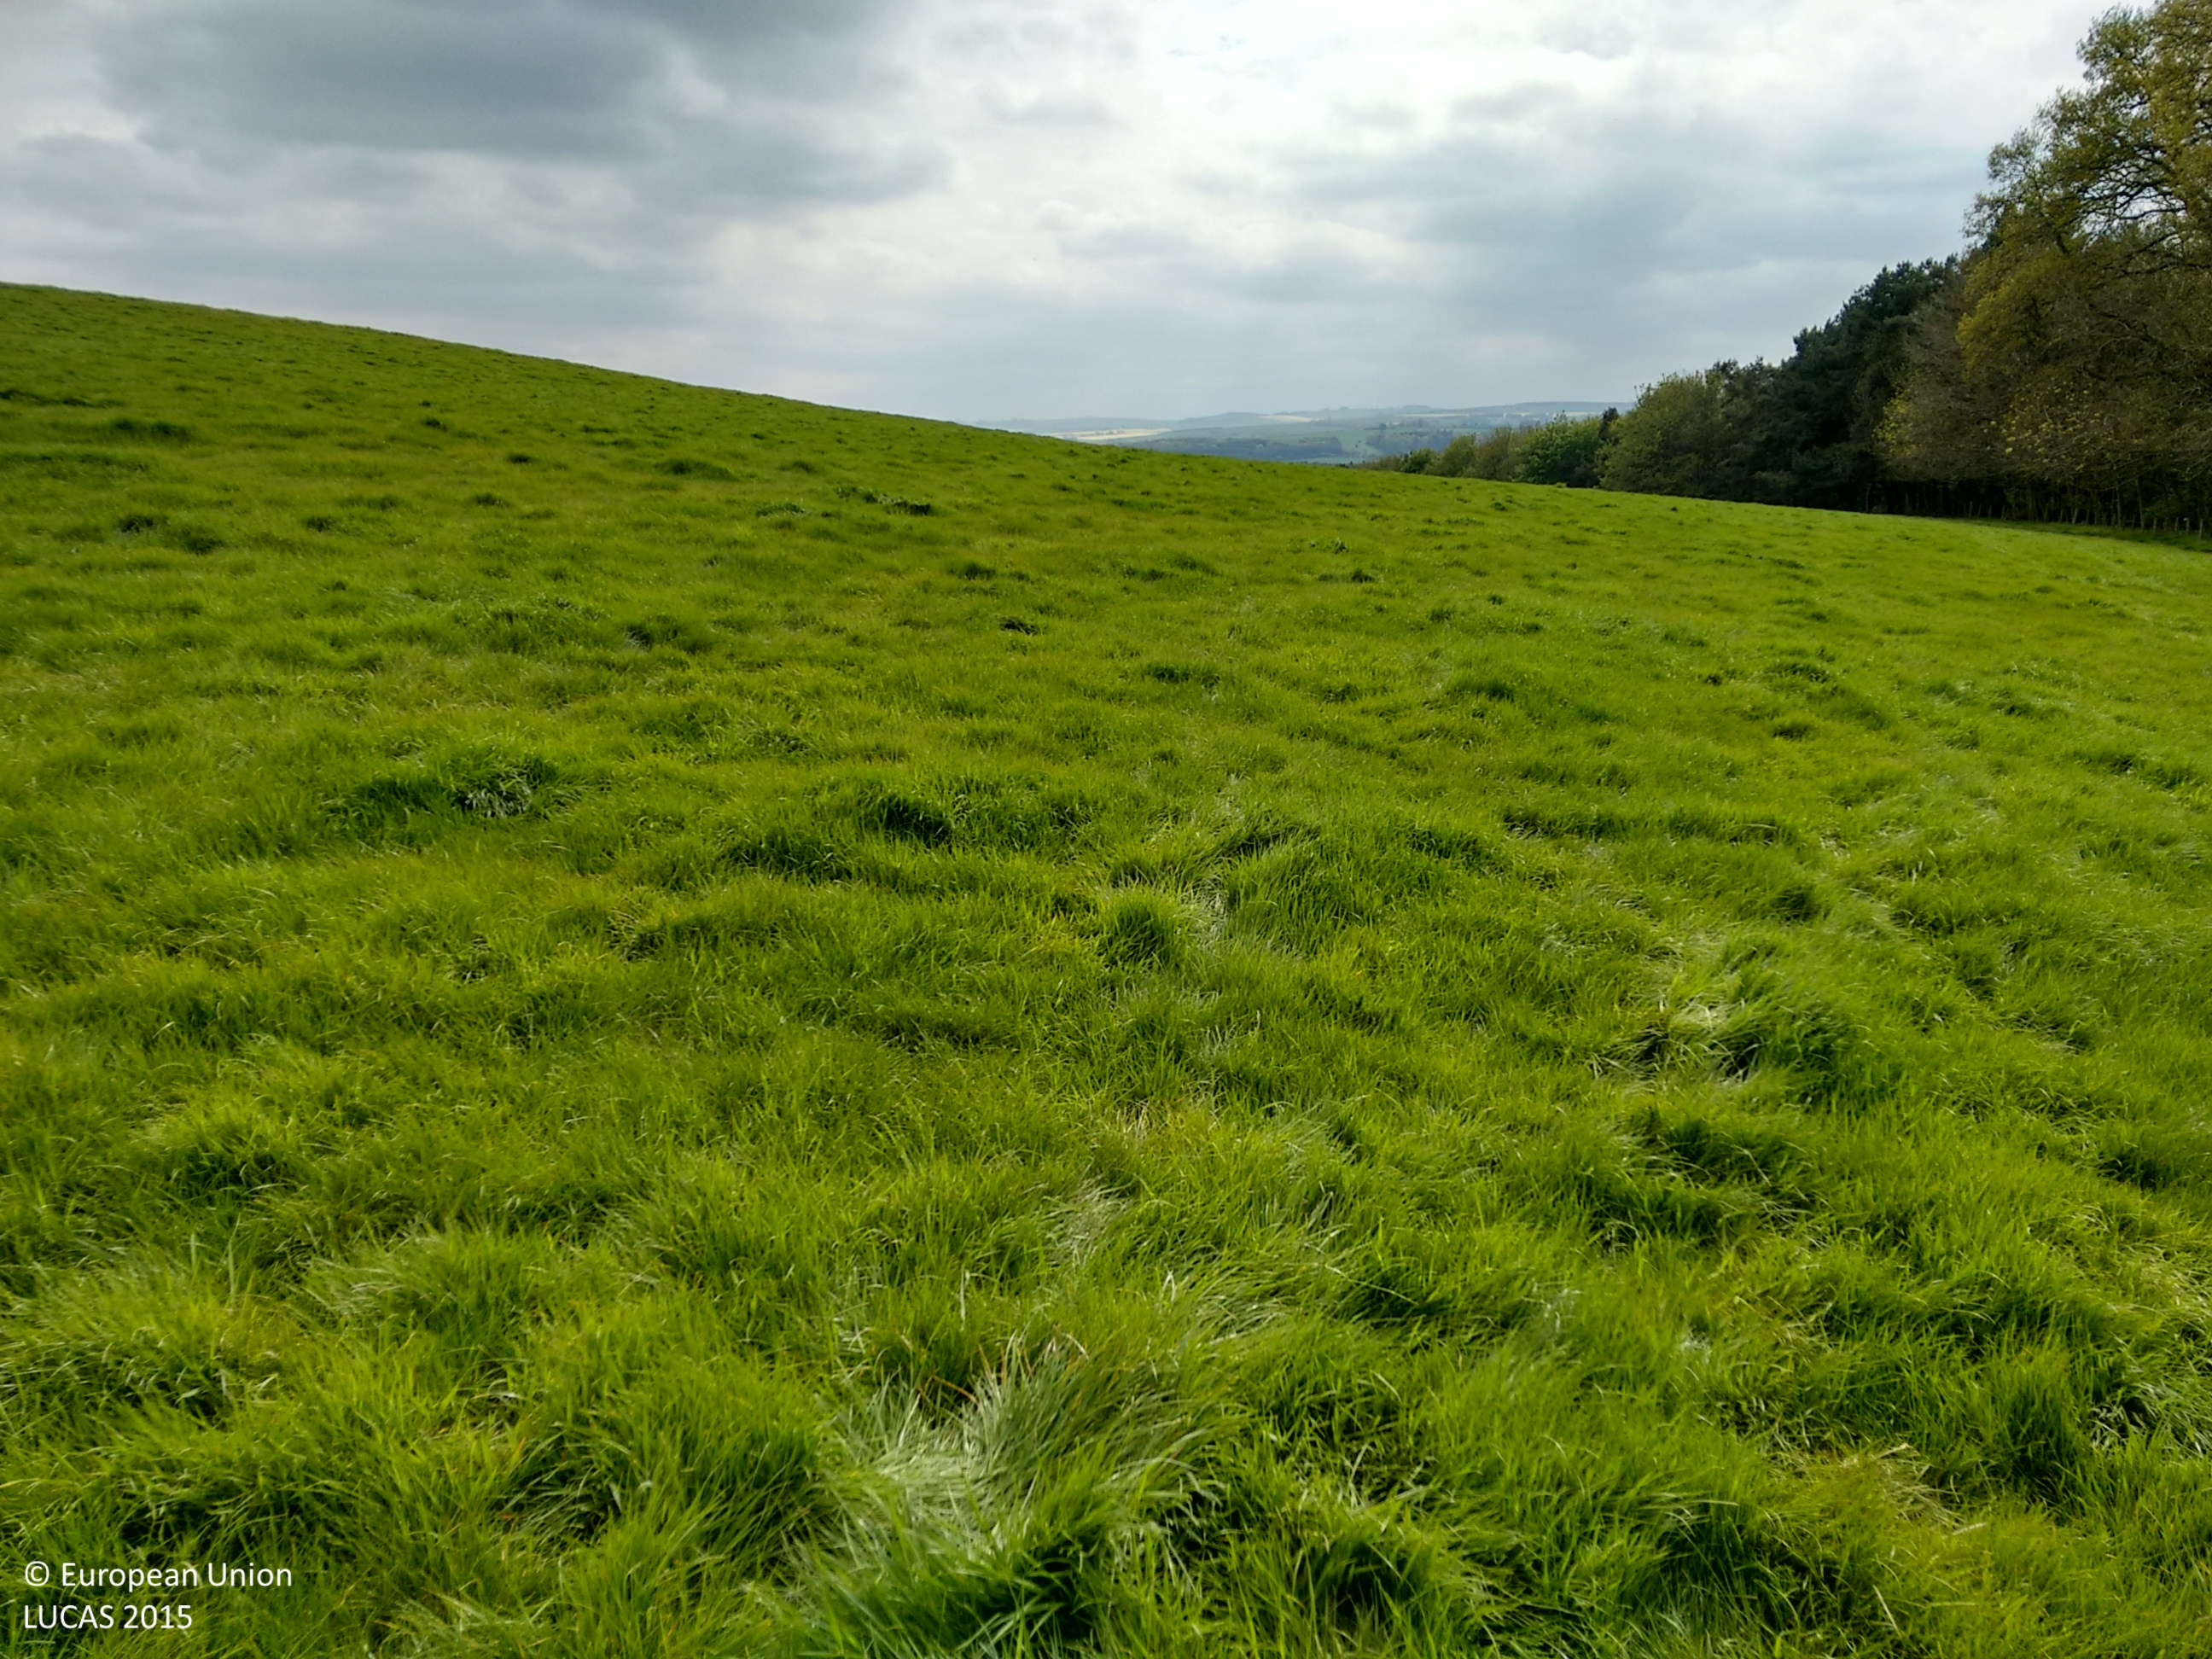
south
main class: Grassland
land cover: Grassland without tree/shrub cover
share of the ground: > 75 %
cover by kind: herbaceous plants 100 %
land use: Agriculture (excluding fallow land and kitchen gardens)
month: May
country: GB
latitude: 55.6677
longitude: -2.2828
